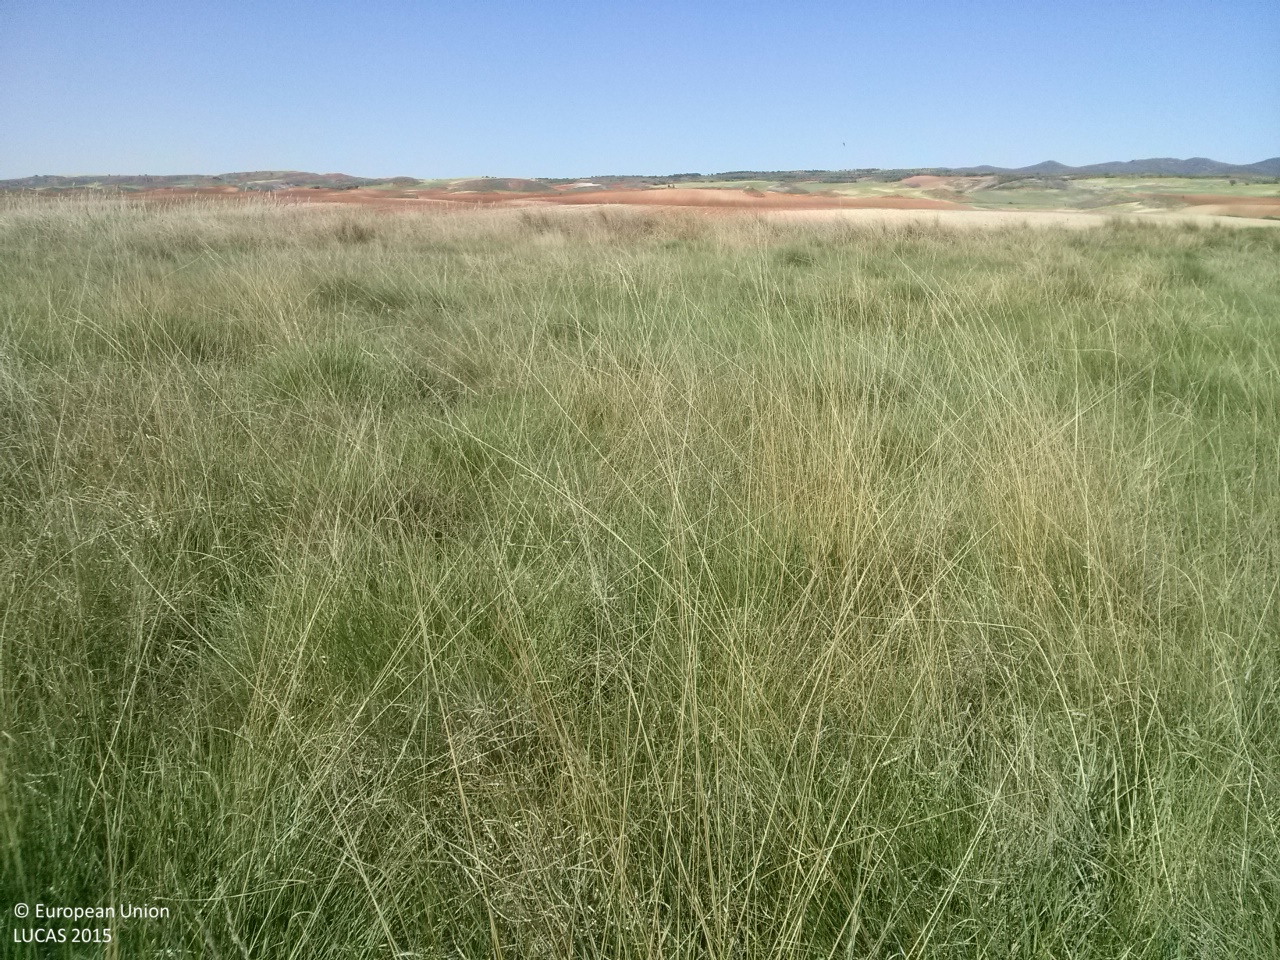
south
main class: Grassland
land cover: Grassland without tree/shrub cover
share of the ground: > 75 %
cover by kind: herbaceous plants 100 %
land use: Semi-natural and natural areas not in use
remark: Temporary flooded
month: May
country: ES
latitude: 40.1827
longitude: -2.7425
